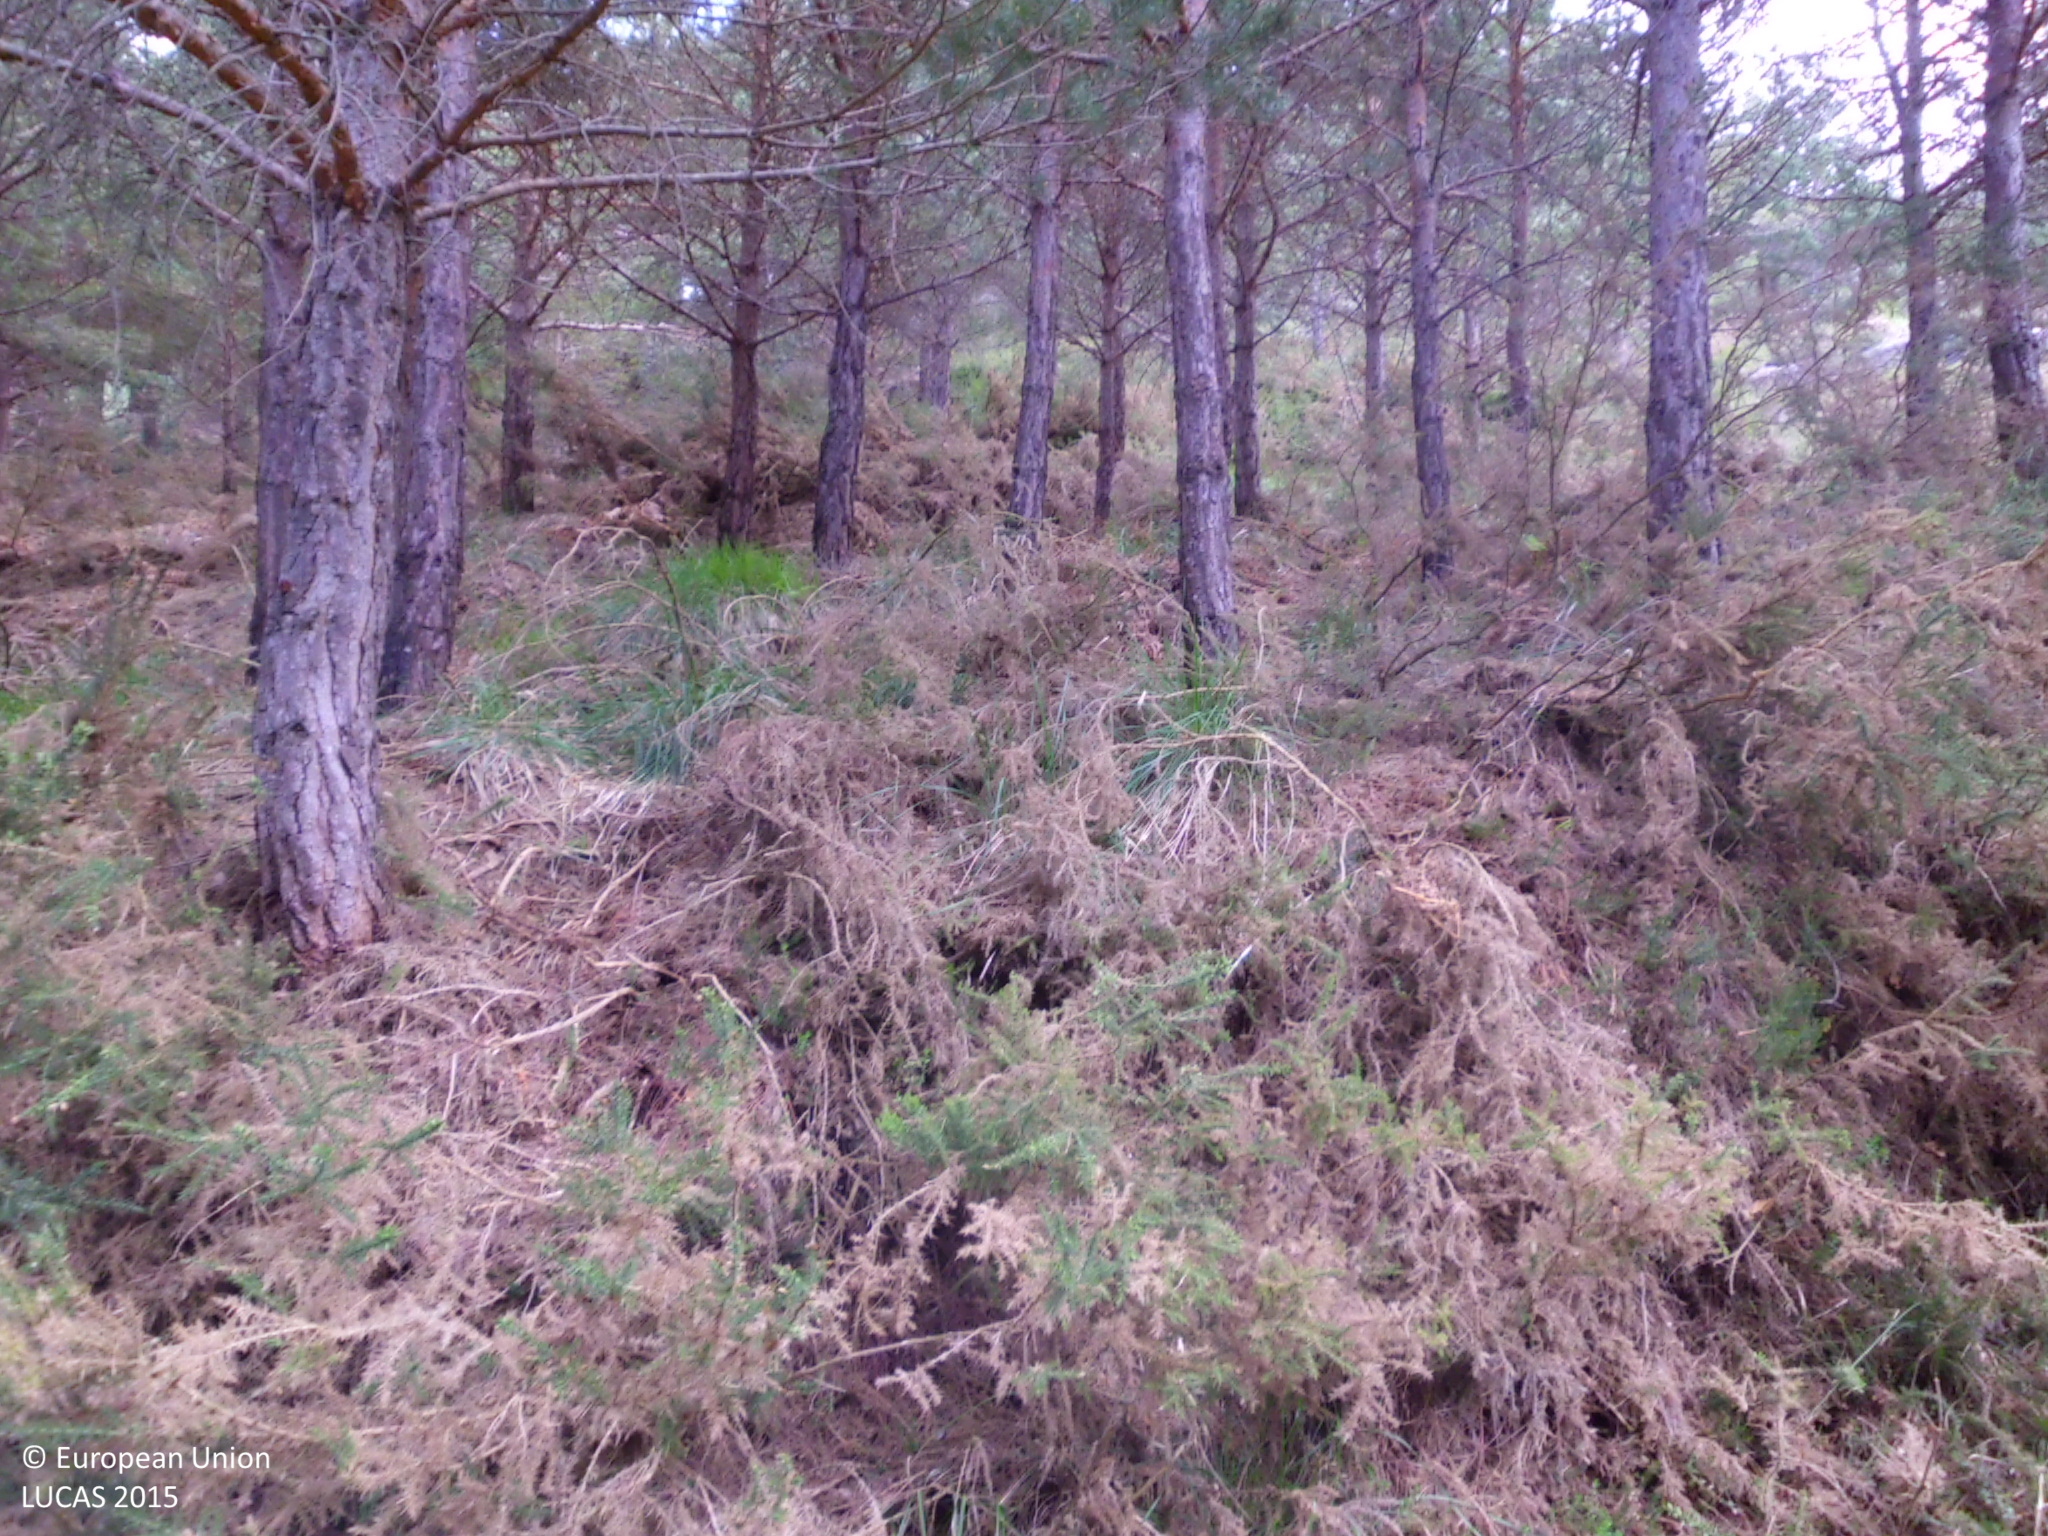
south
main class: Woodland
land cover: Pine dominated coniferous woodland
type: coniferous forest of the mediterranean region
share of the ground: > 75 %
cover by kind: coniferous forest trees 100 %
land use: Semi-natural and natural areas not in use
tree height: > 5 m
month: May
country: ES
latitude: 42.8839
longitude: -3.8676
